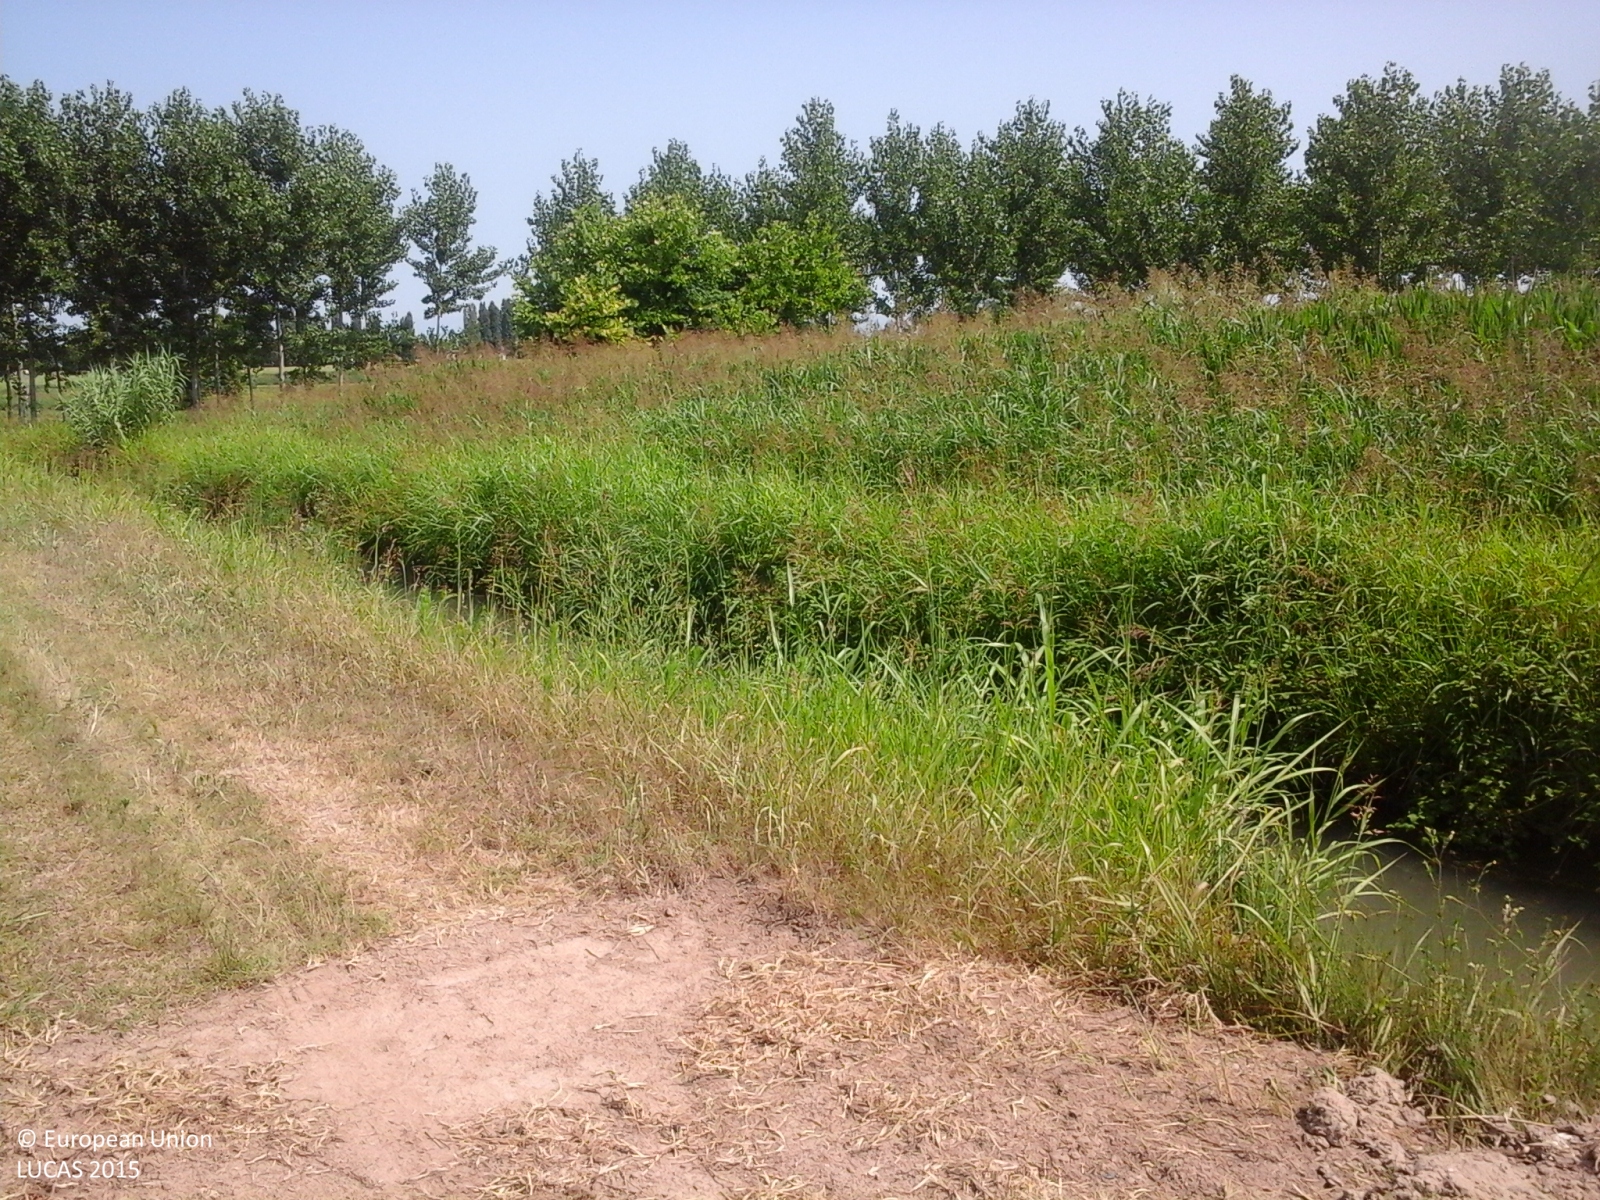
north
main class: Cropland
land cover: Maize
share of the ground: > 75 %
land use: Agriculture (excluding fallow land and kitchen gardens)
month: July
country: IT
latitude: 45.2836
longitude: 10.9799
